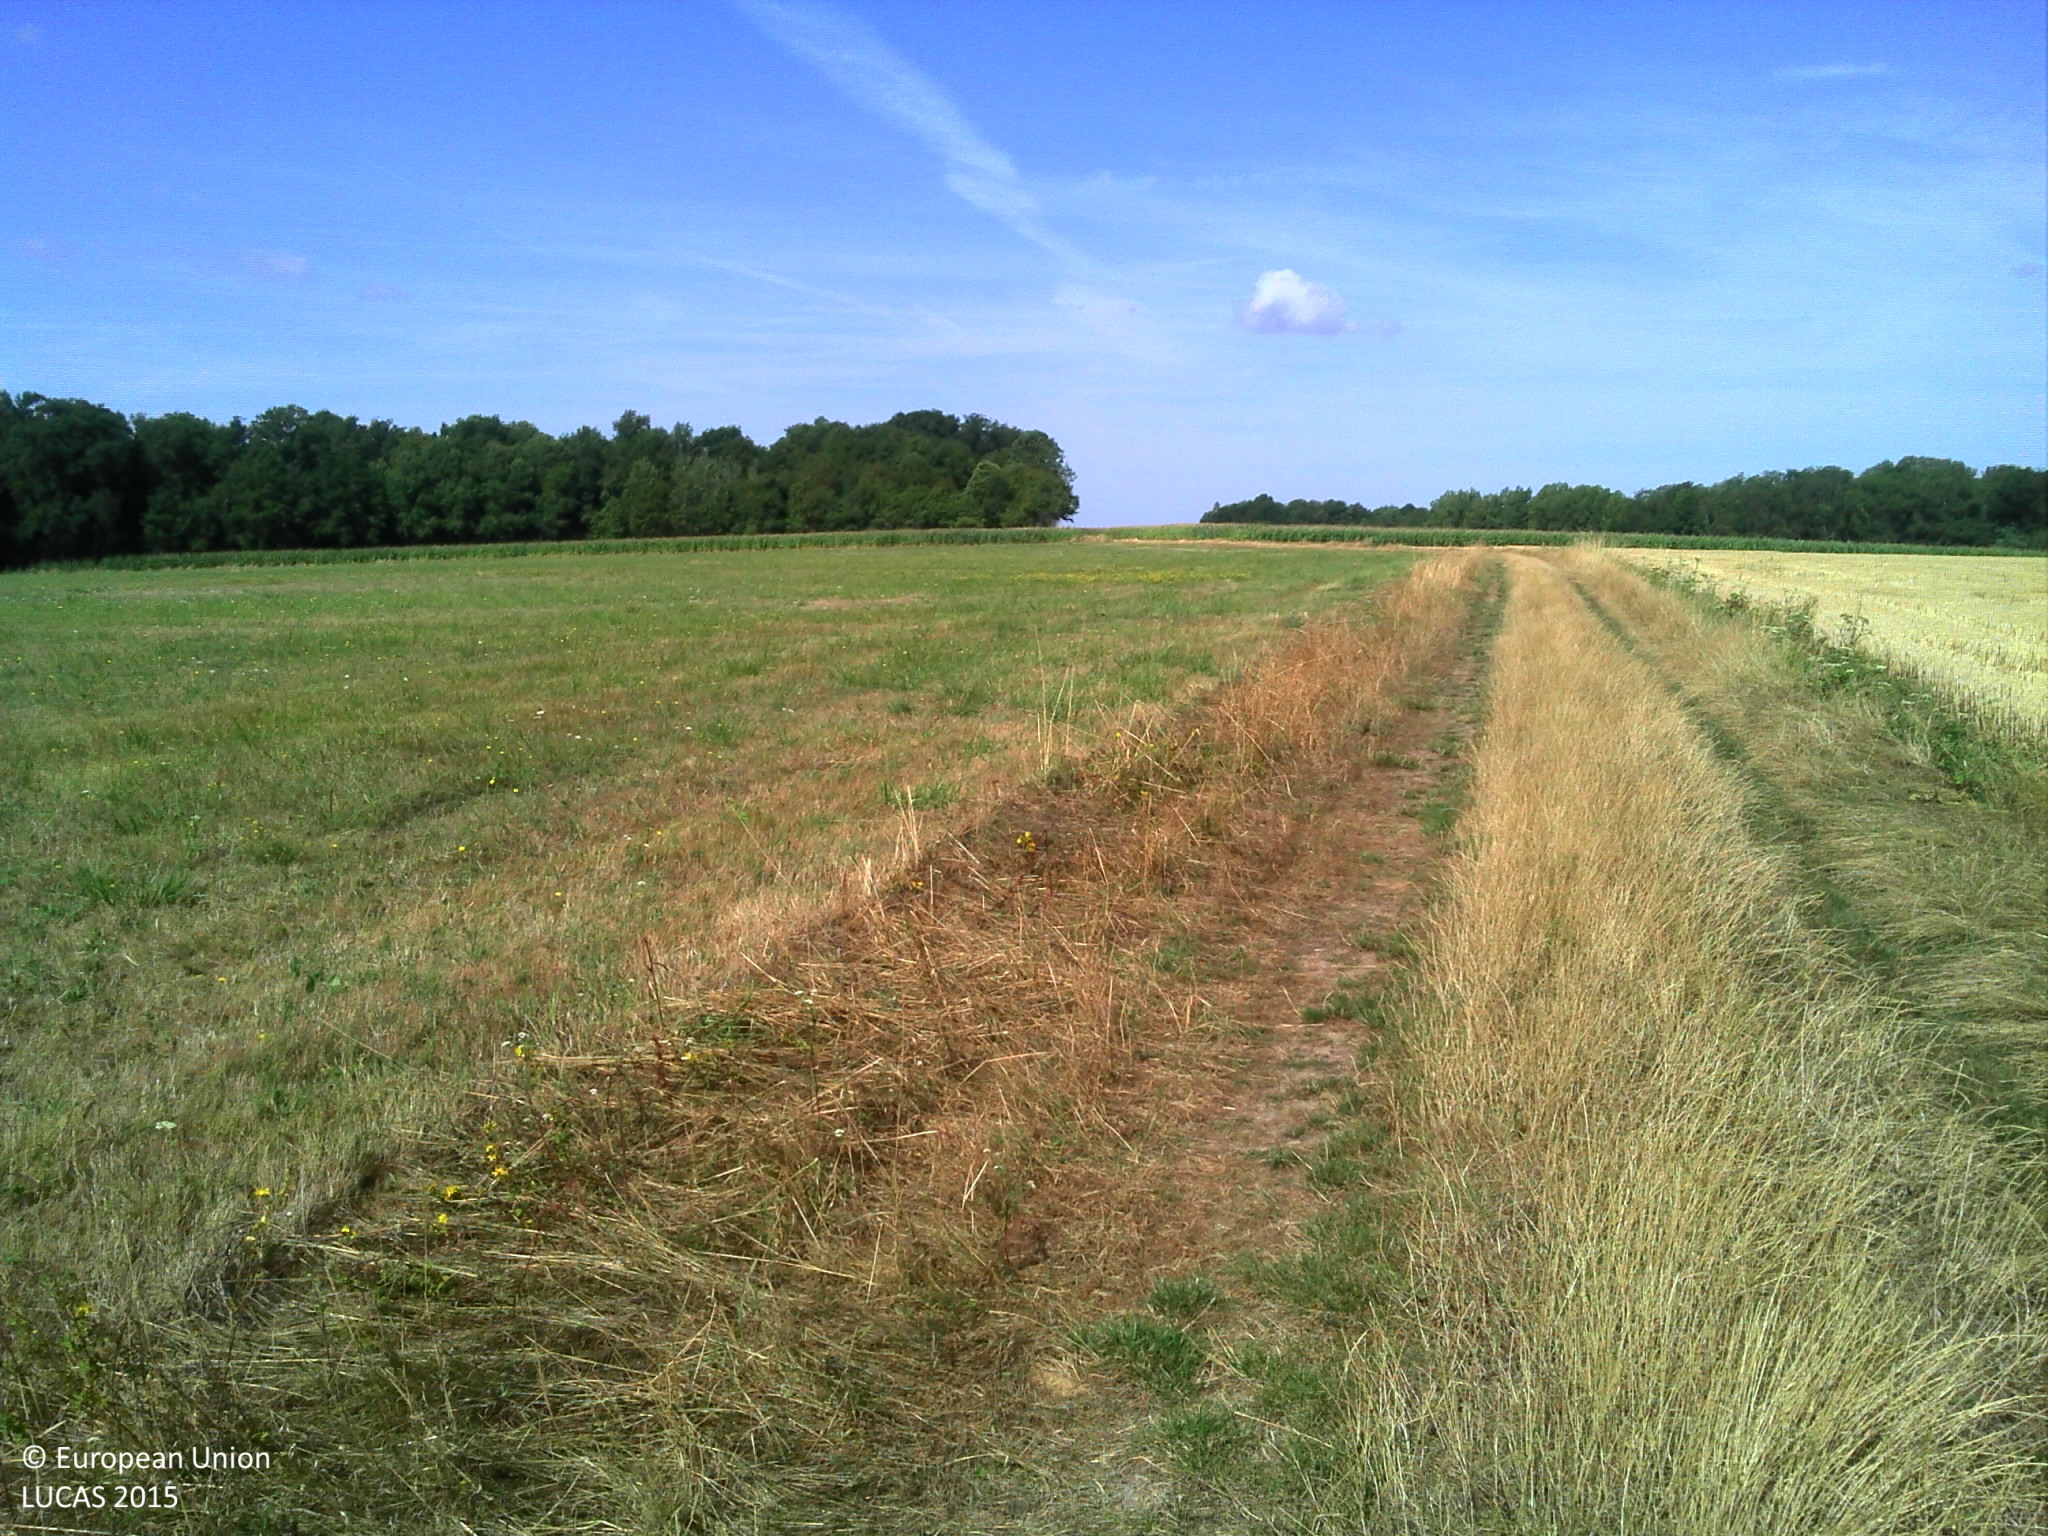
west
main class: Artificial land
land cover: Non built-up linear features
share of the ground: > 75 %
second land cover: Grassland without tree/shrub cover
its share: > 75 %
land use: Road transport
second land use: Agriculture (excluding fallow land and kitchen gardens)
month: August
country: FR
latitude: 48.7444
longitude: 3.3429
